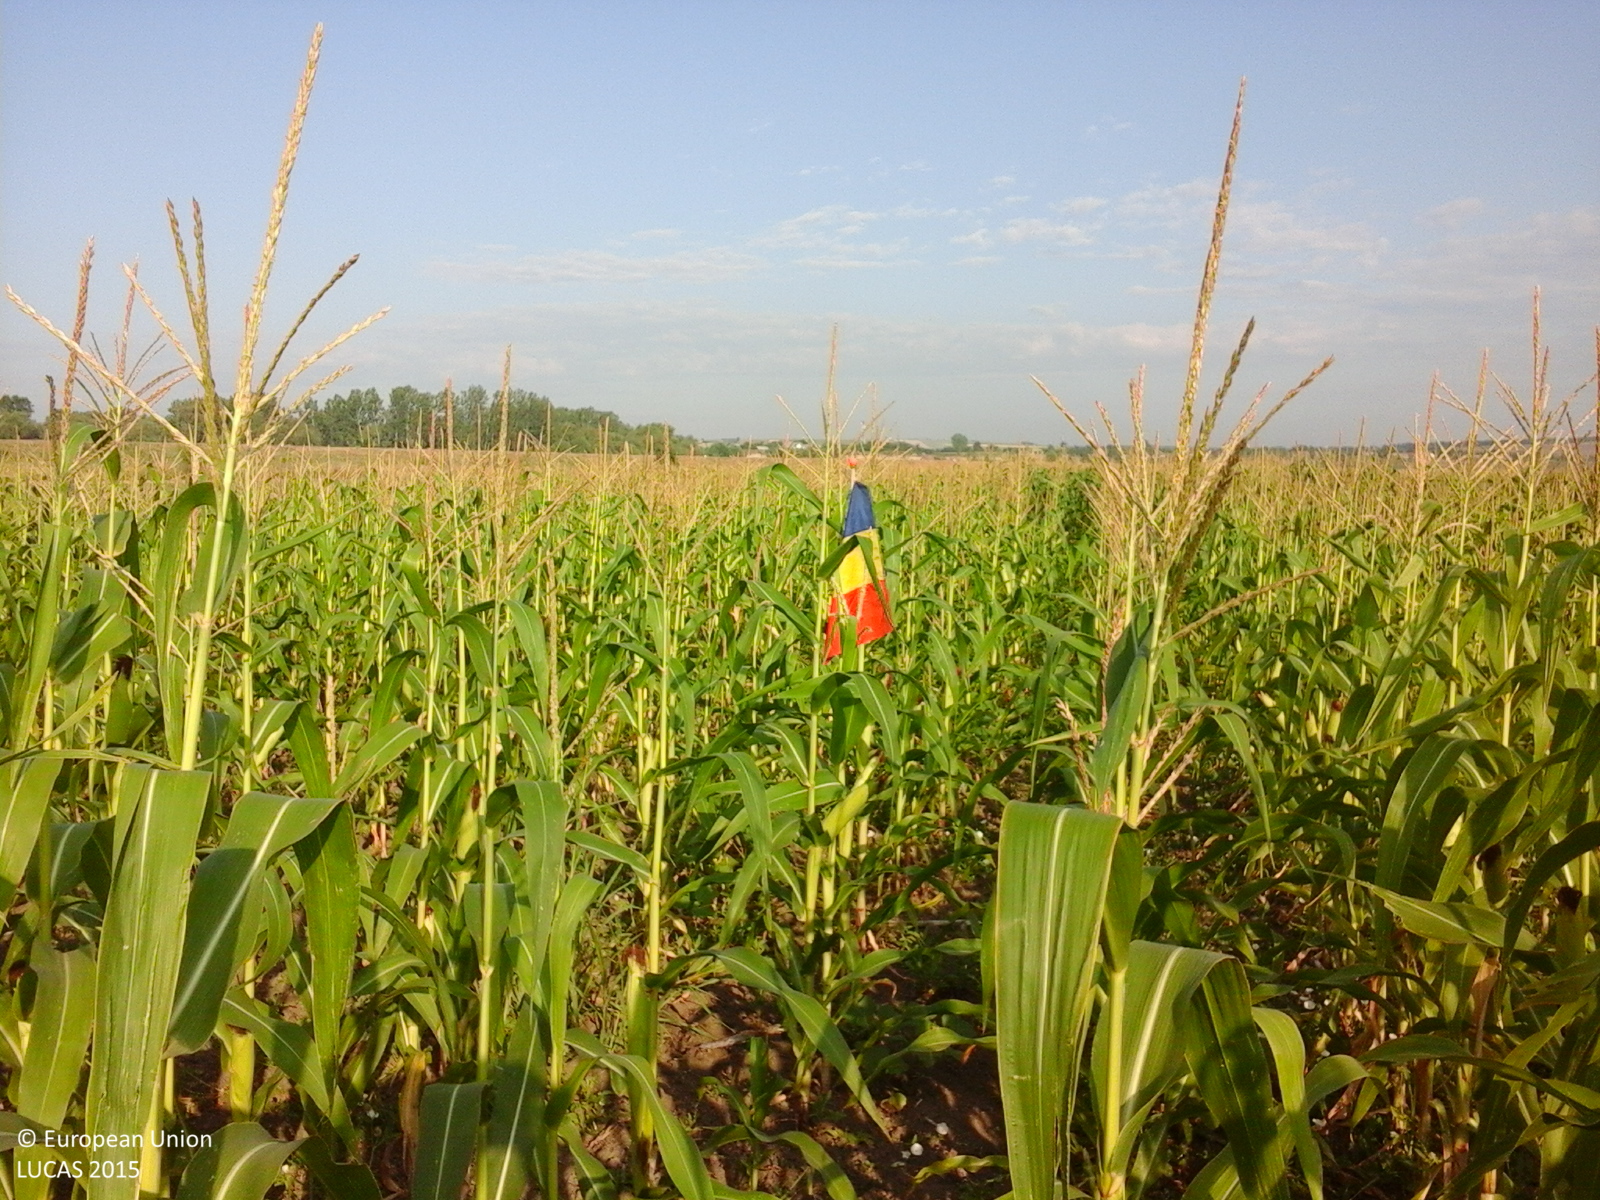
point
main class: Cropland
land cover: Maize
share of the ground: > 75 %
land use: Agriculture (excluding fallow land and kitchen gardens)
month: July
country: RO
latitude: 46.2921
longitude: 28.1604
